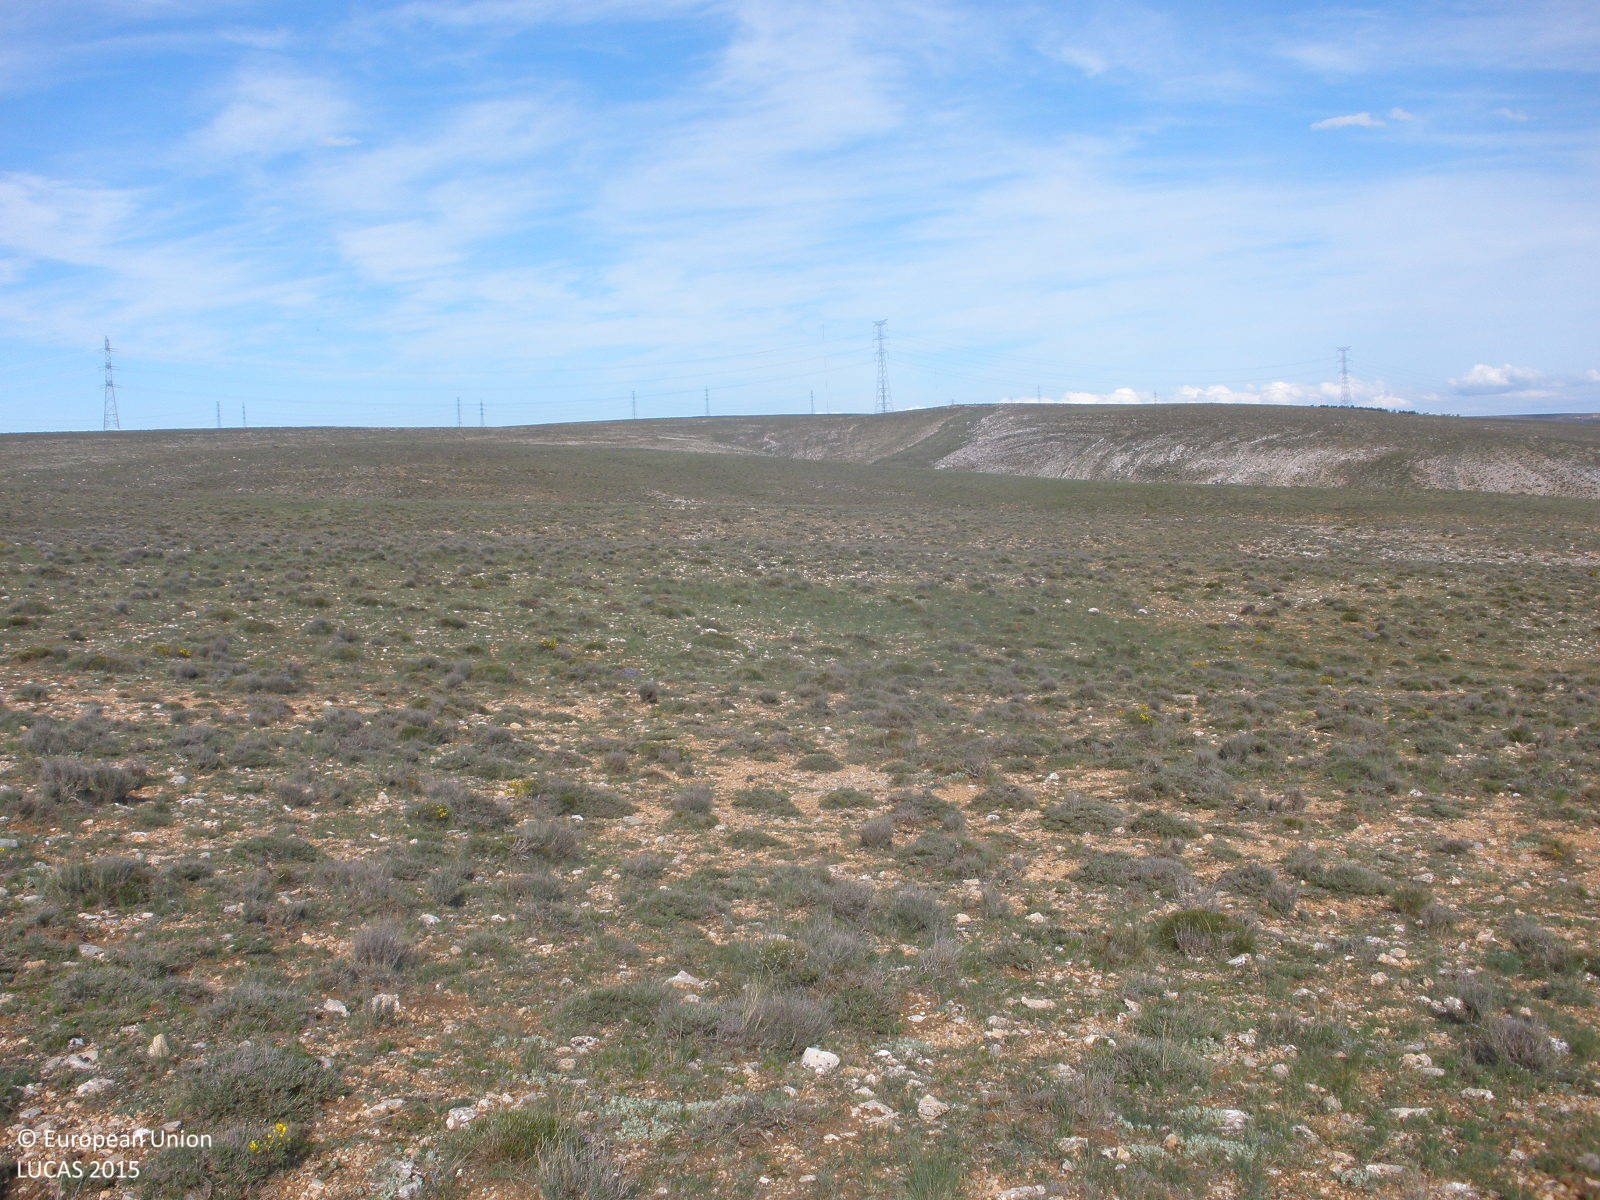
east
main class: Shrubland
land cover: Shrubland without tree cover
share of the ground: 50 - 75 %
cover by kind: shrubs 60 %, herbaceous plants 30 %, consolidated bare surface 10 %
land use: Semi-natural and natural areas not in use
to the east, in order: Shrubland without tree cover
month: May
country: ES
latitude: 40.7525
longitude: -0.8982
